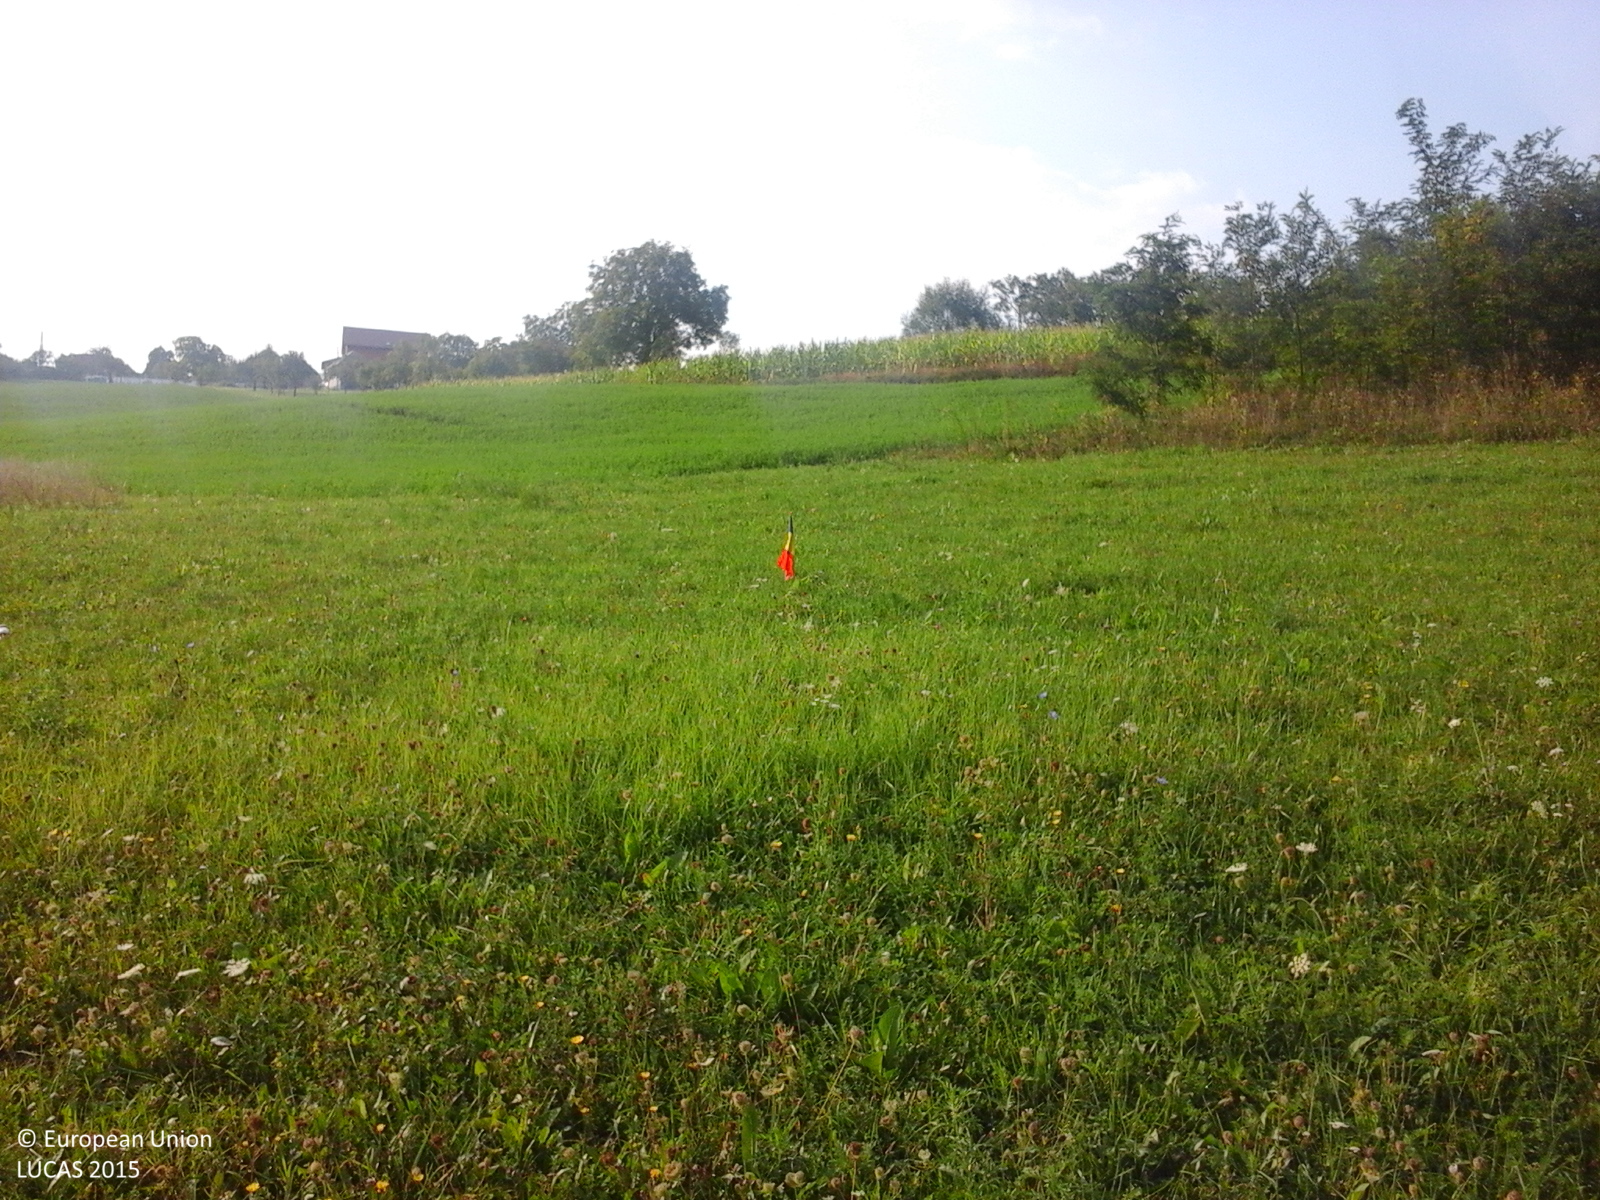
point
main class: Cropland
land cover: Other leguminous and mixtures for fodder
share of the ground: > 75 %
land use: Agriculture (excluding fallow land and kitchen gardens)
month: September
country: RO
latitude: 46.9504
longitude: 22.6033
